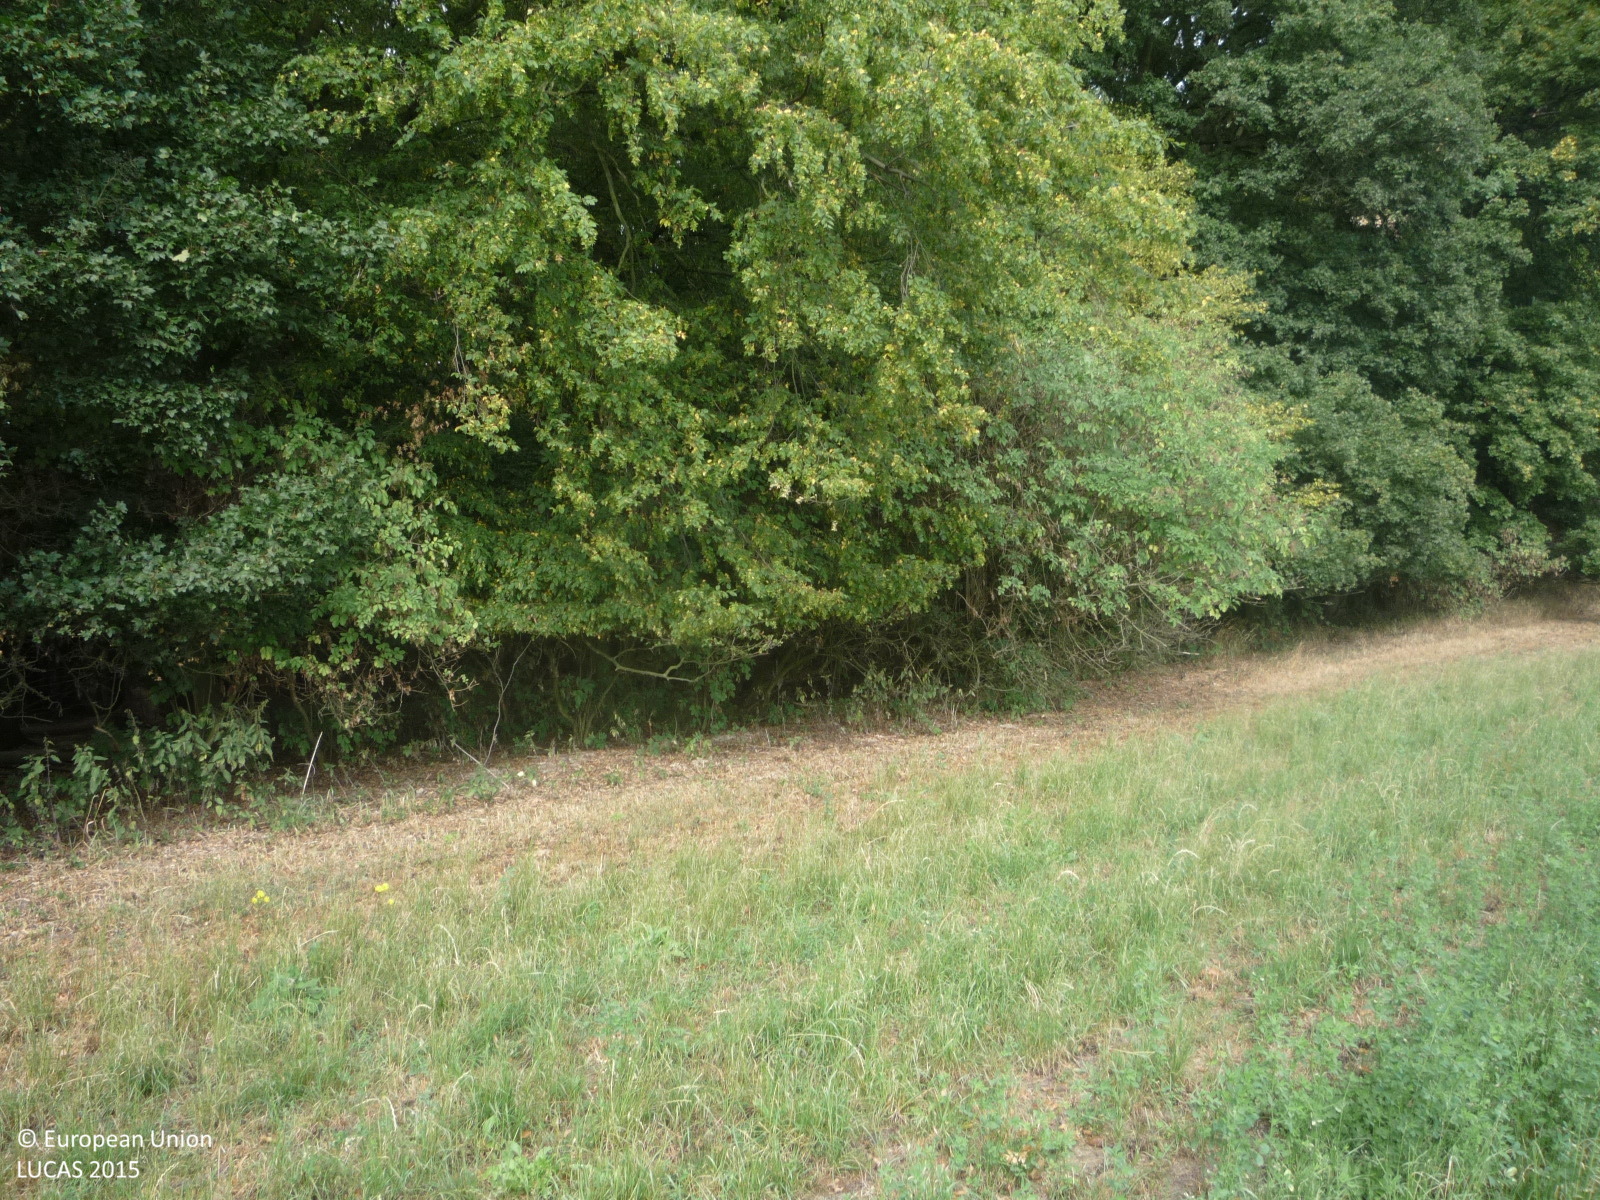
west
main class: Cropland
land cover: Lucerne
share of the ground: > 75 %
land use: Agriculture (excluding fallow land and kitchen gardens)
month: July
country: CZ
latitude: 50.3903
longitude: 15.1935
